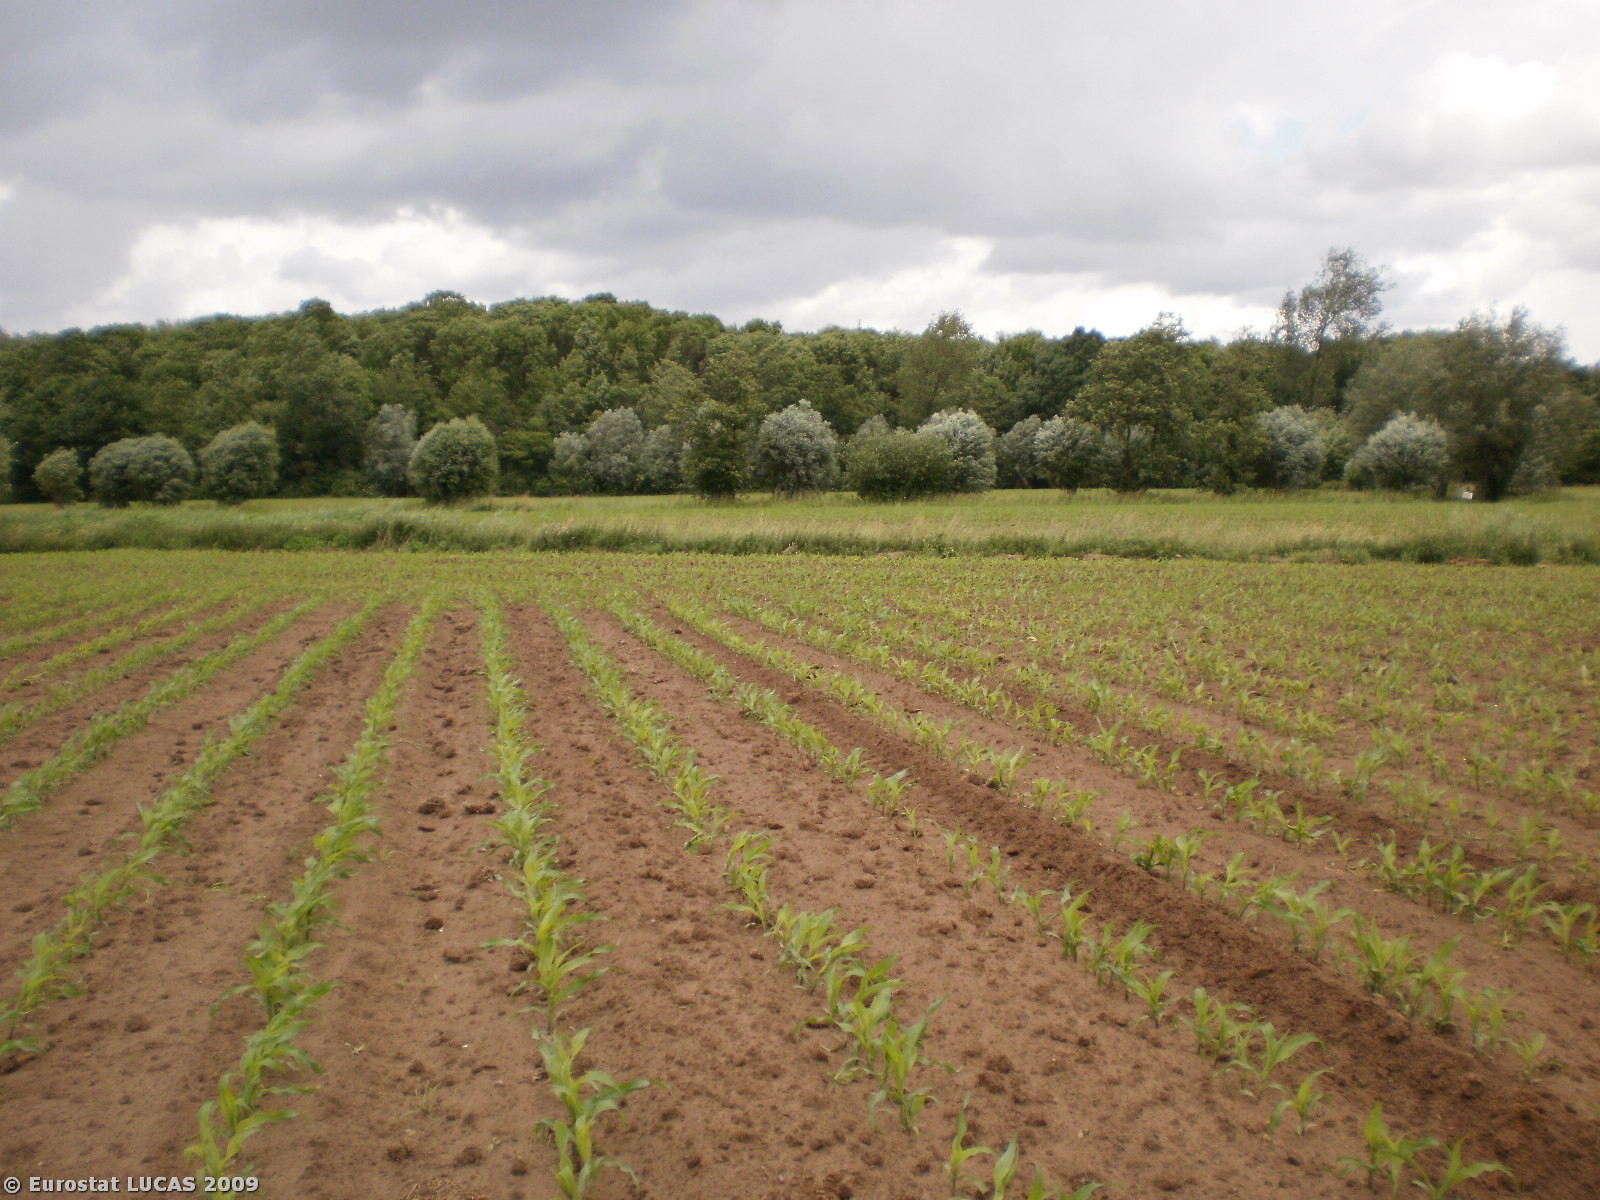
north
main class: Cropland
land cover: Maize
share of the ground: 10 - 25 %
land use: Agriculture (excluding fallow land and kitchen gardens)
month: June
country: BE
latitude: 51.0843
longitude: 4.2419
